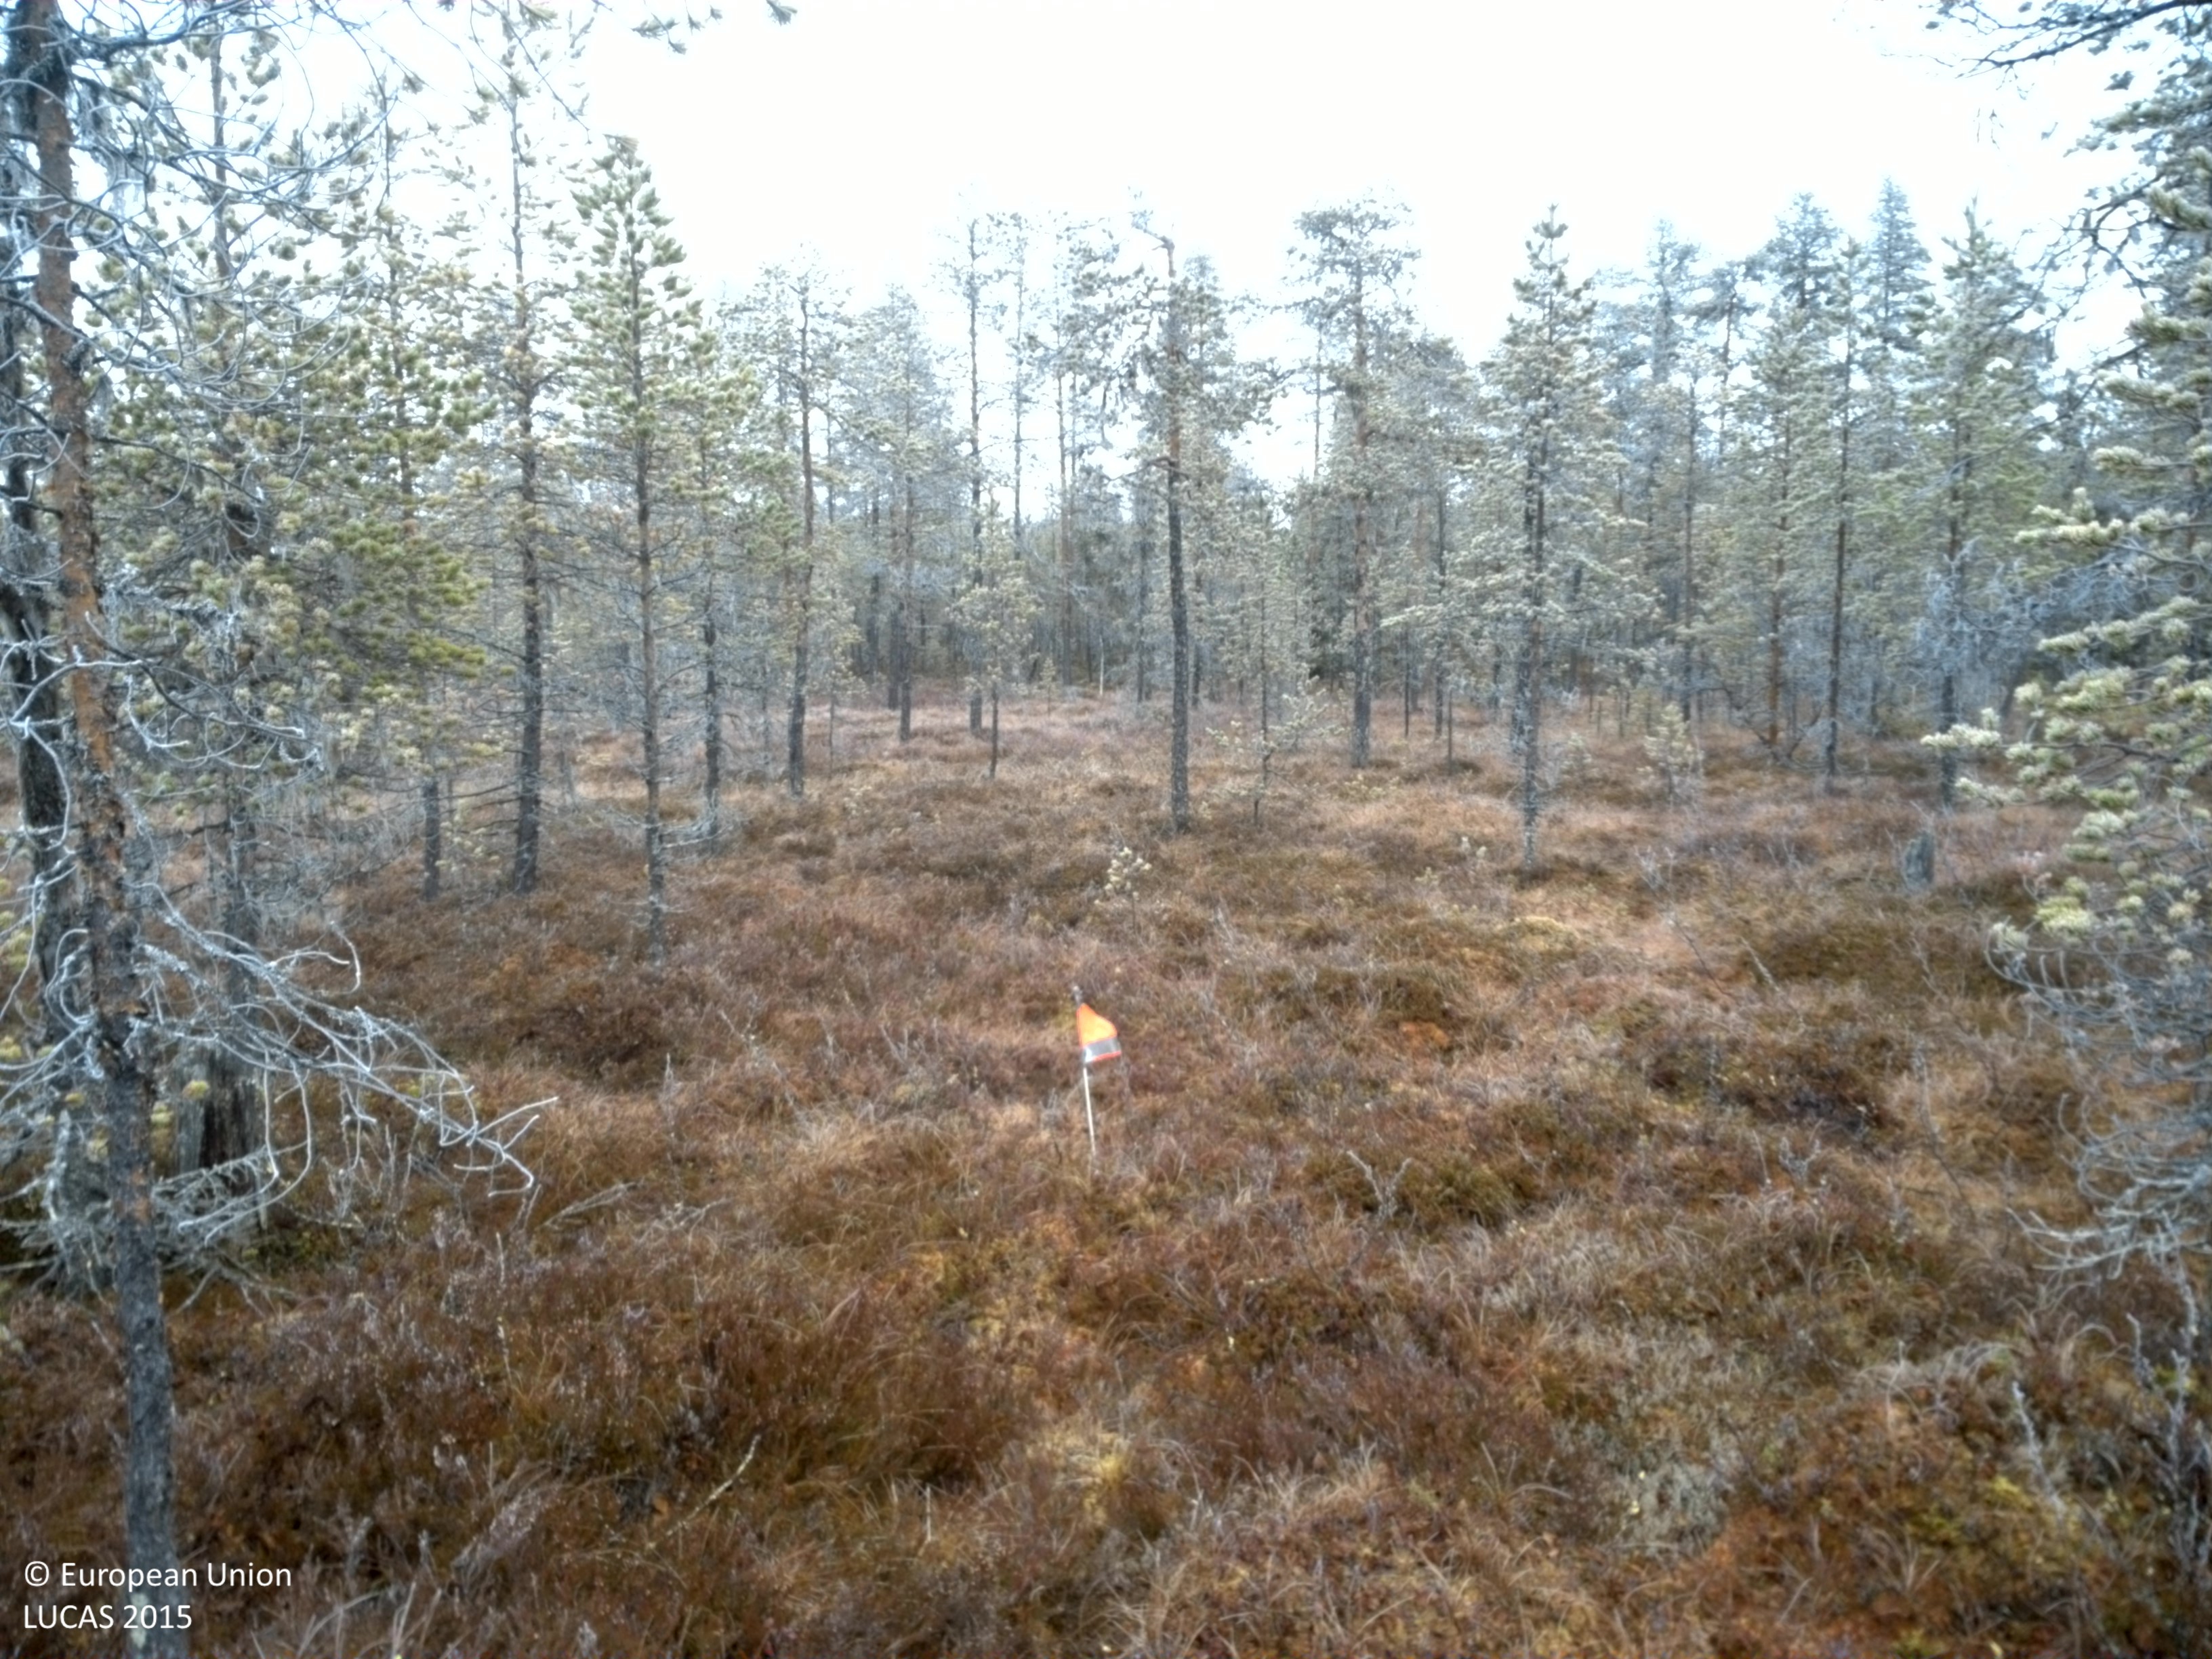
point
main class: Woodland
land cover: Pine dominated coniferous woodland
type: mire and swamp forests
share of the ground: 10 - 25 %
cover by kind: shrubs 35 %, lichens and mosses 30 %, coniferous forest trees 20 %, herbaceous plants 15 %
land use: Semi-natural and natural areas not in use
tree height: > 5 m
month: October
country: SE
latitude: 64.5090
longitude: 16.7357
